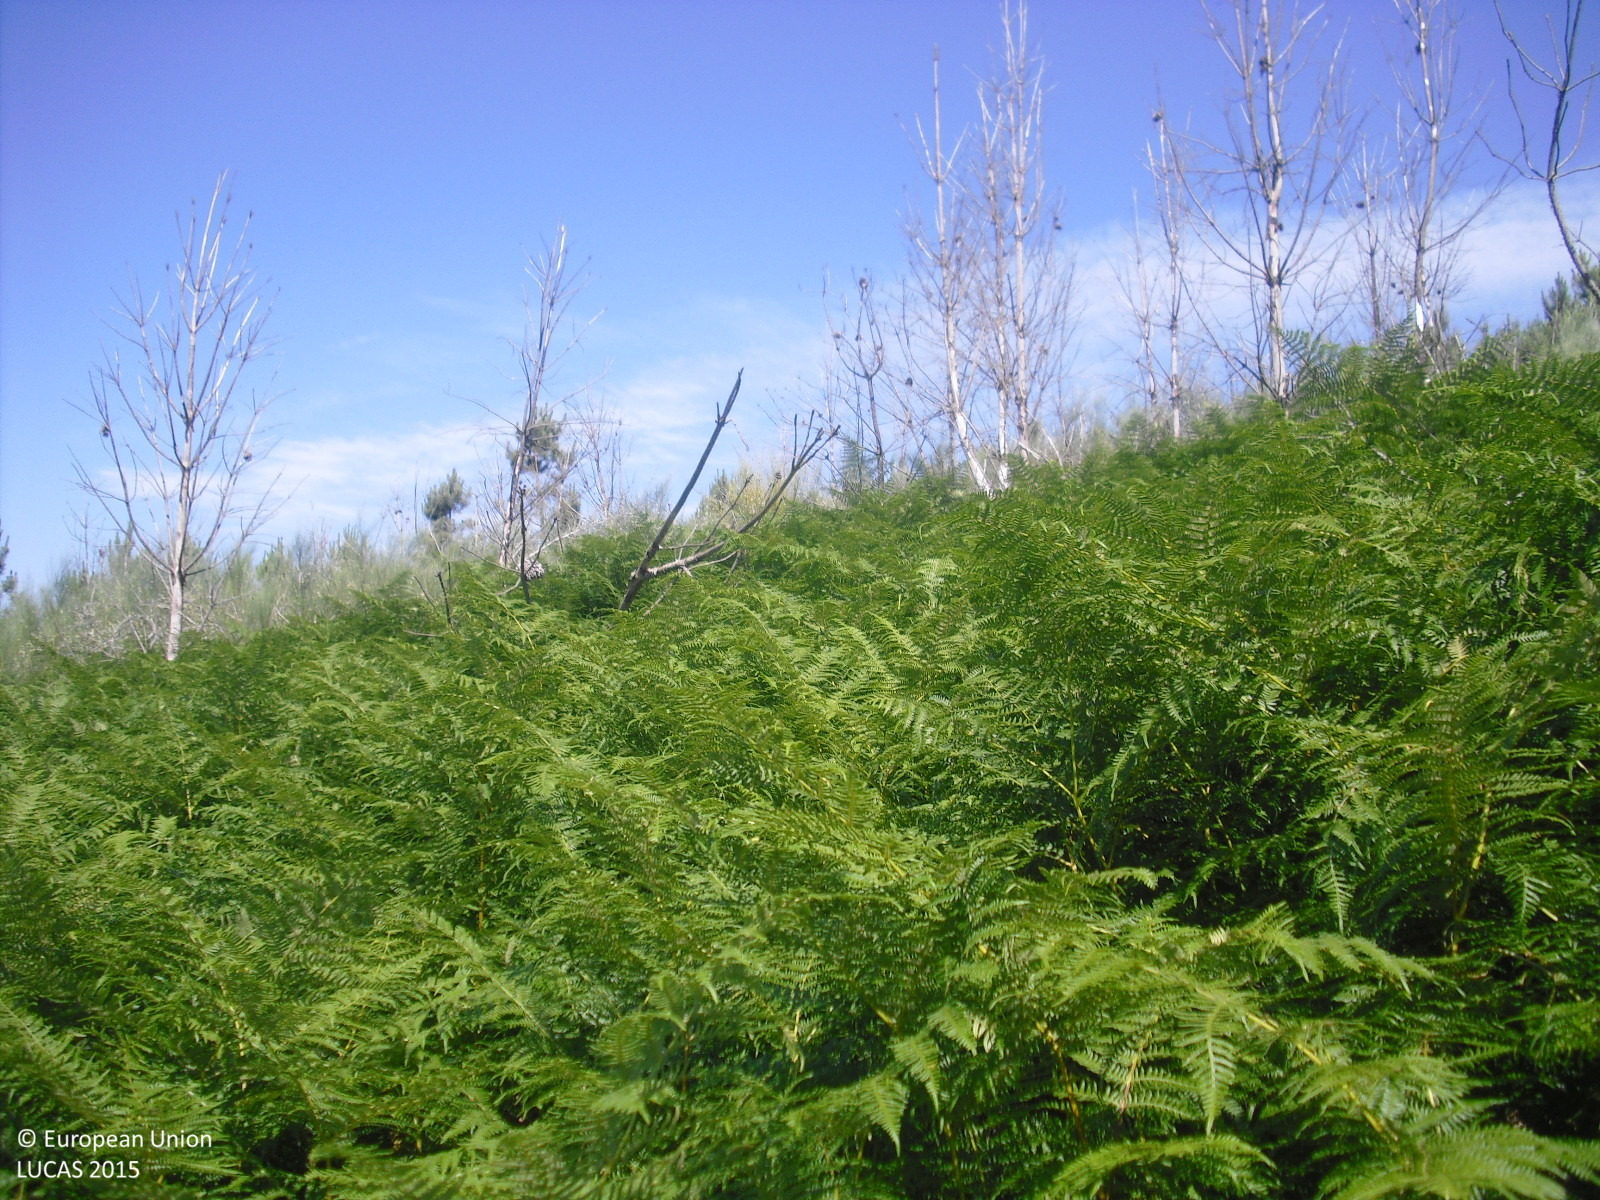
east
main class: Shrubland
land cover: Shrubland with sparse tree cover
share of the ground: > 75 %
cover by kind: shrubs 95 %, broadleaved forest trees 5 %
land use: Forestry
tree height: < 5 m
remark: Burnt area
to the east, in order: Shrubland with sparse tree cover; Pine dominated coniferous woodland; Pine dominated mixed woodland
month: July
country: ES
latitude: 42.6422
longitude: -7.5244
